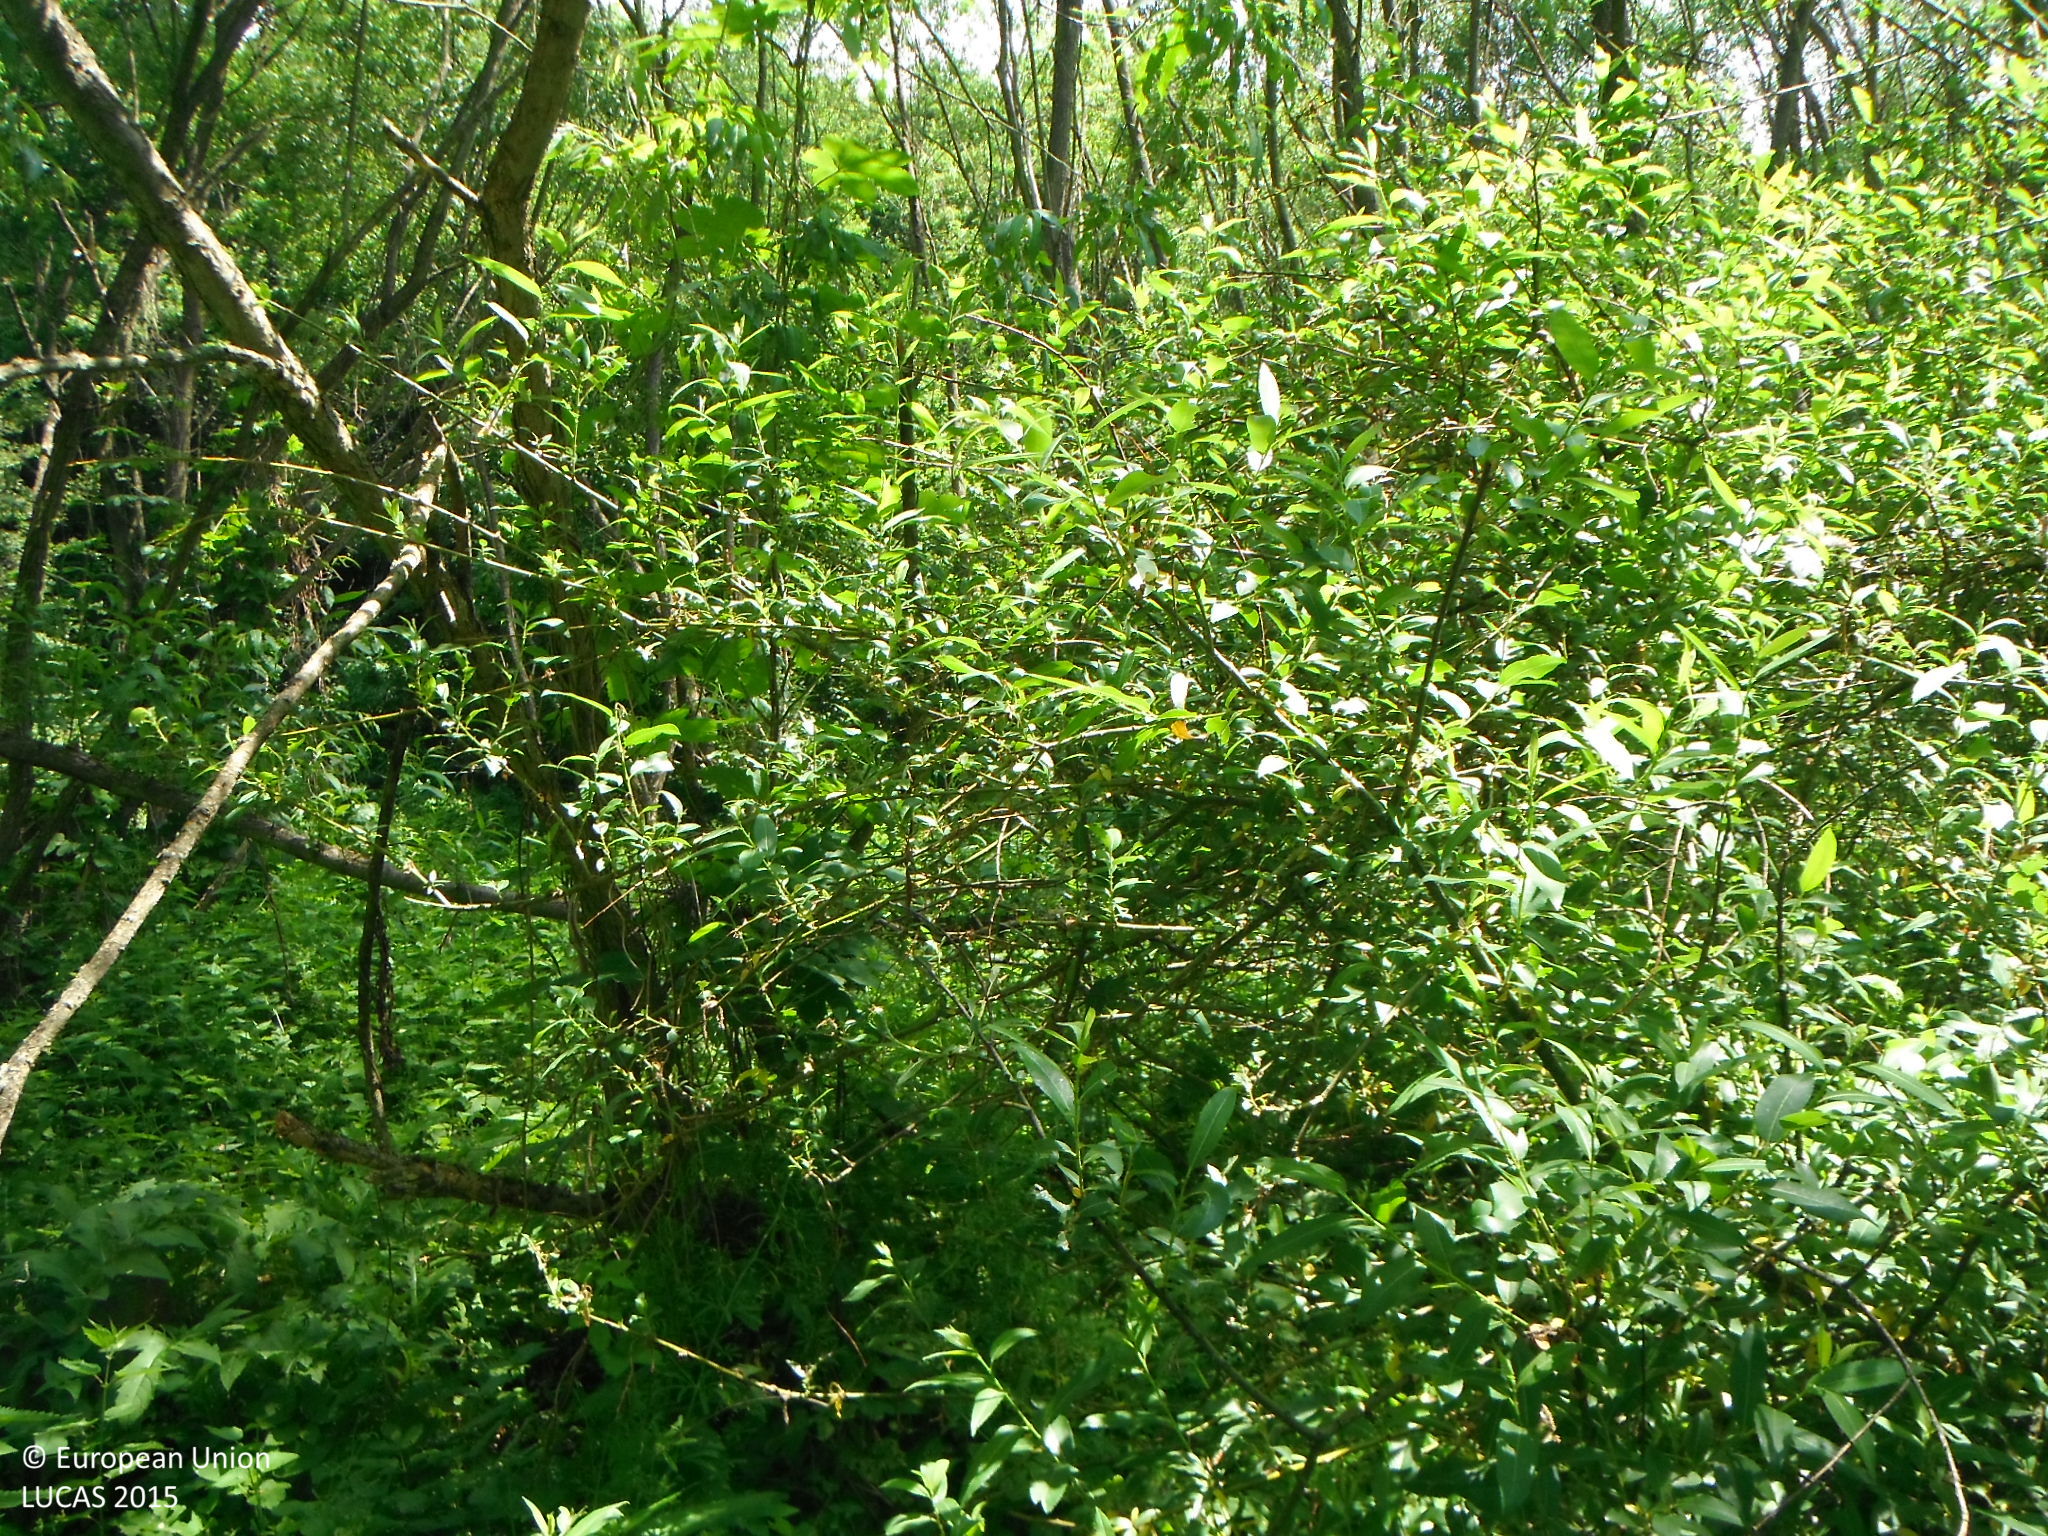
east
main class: Woodland
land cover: Broadleaved woodland
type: mire and swamp forests
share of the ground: > 75 %
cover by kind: broadleaved forest trees 85 %, shrubs 10 %, herbaceous plants 5 %
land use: Semi-natural and natural areas not in use
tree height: > 5 m
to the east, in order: Broadleaved woodland; Rivers and streams; Shrubland with sparse tree cover; Electric lines; Shrubland with sparse tree cover; Broadleaved woodland
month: June
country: SK
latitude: 48.6876
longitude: 19.2191
